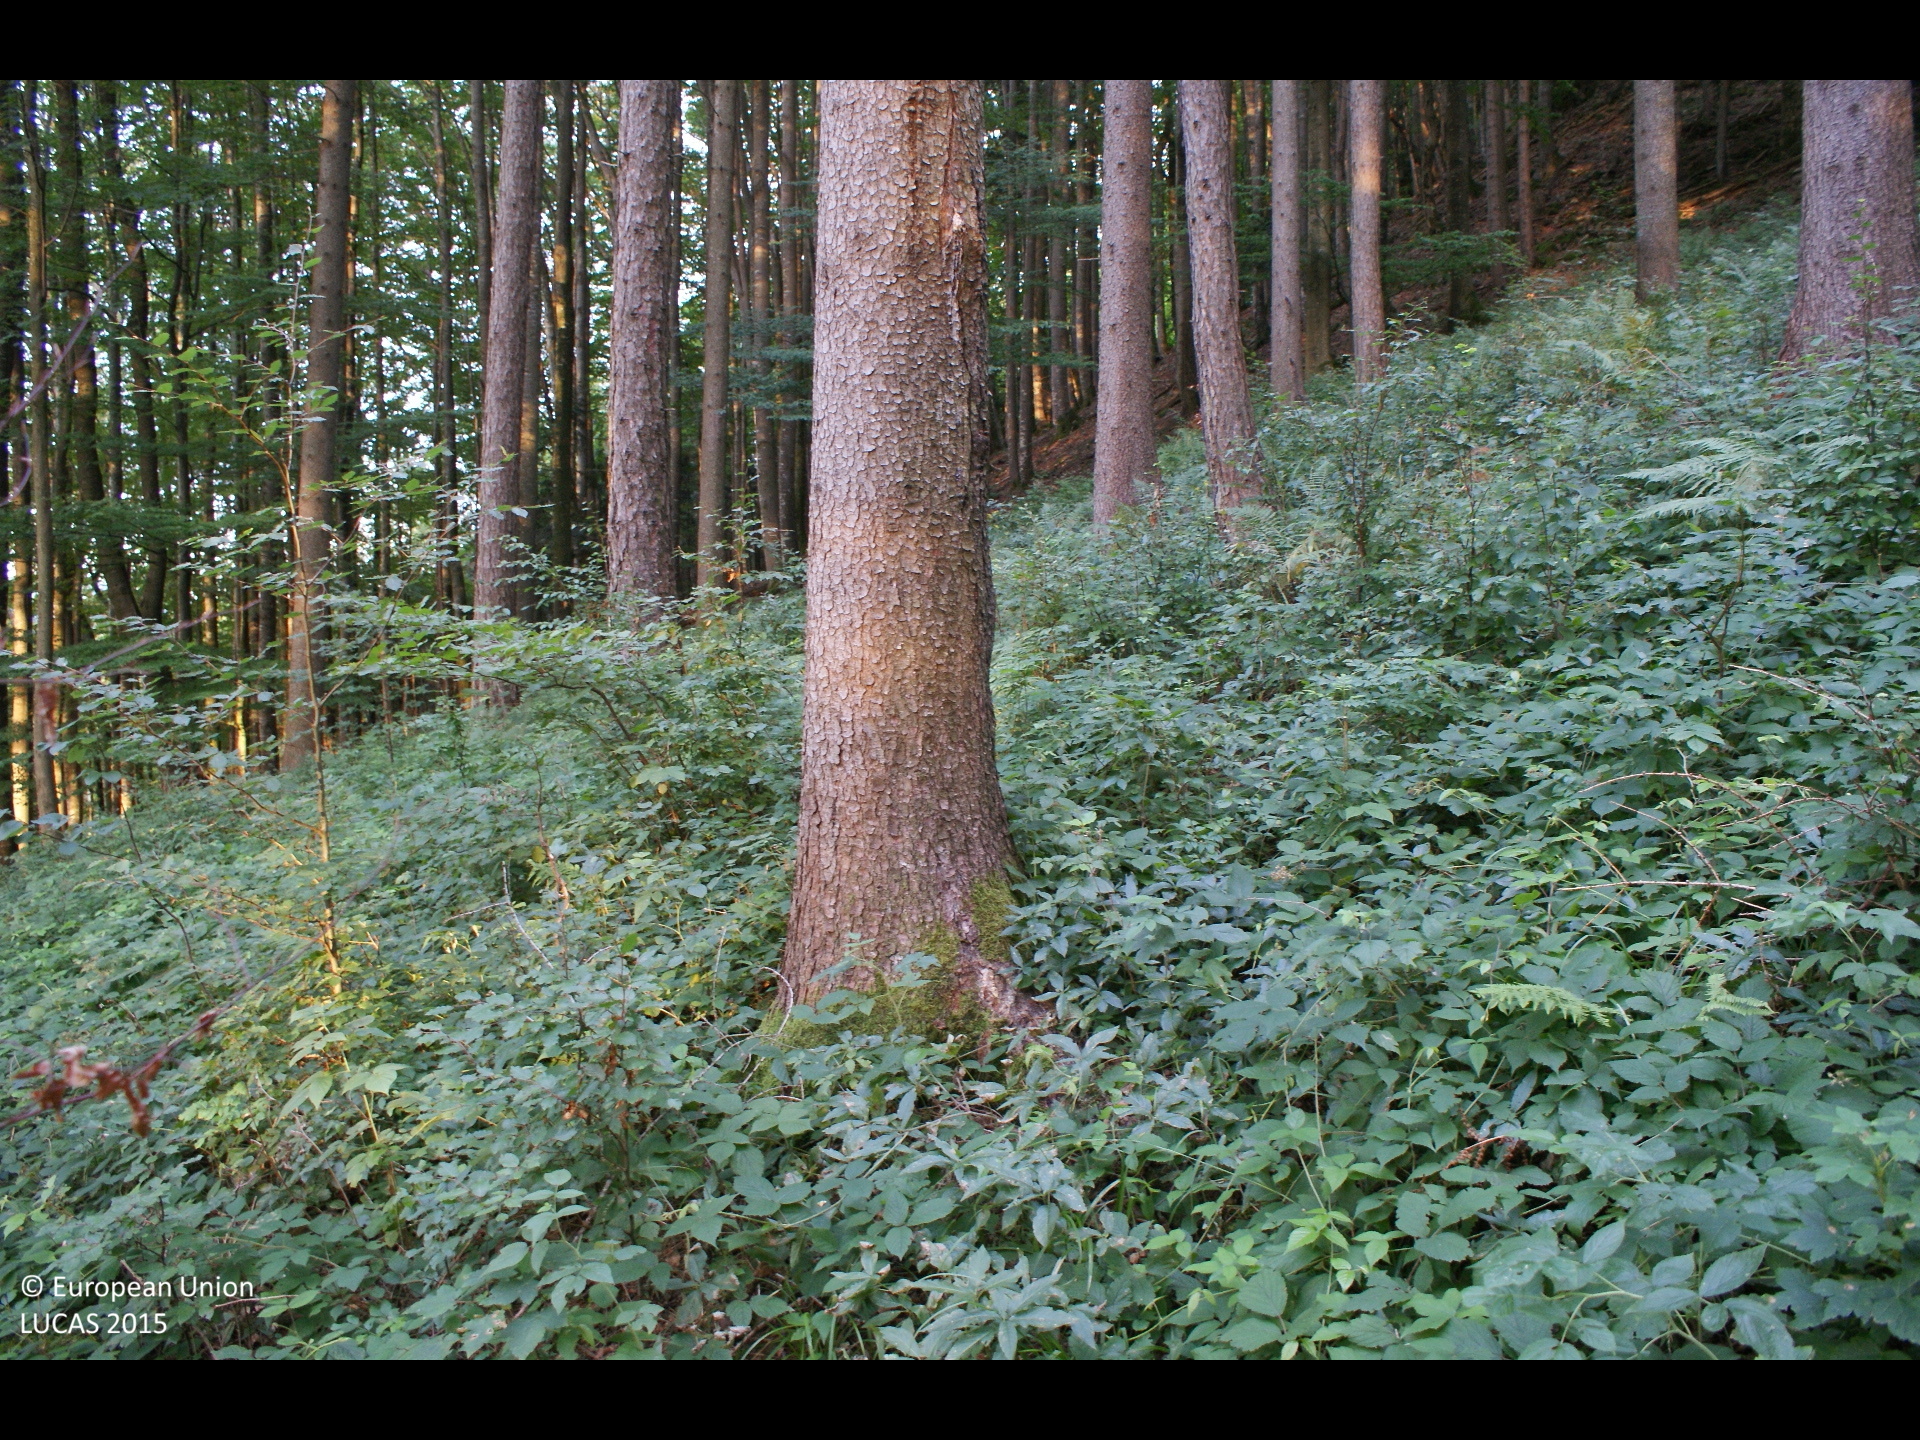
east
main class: Woodland
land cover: Other coniferous woodland
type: hemiboreal forest and nemoral coniferous forest and mixed broadleaved-coniferous forest
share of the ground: > 75 %
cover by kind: coniferous forest trees 80 %, herbaceous plants 15 %, shrubs 5 %
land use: Forestry
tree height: > 5 m
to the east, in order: Other coniferous woodland; Broadleaved woodland; Tracks; Spruce dominated mixed woodland; Broadleaved woodland; Tracks
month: July
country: AT
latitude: 47.9373
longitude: 14.8329
